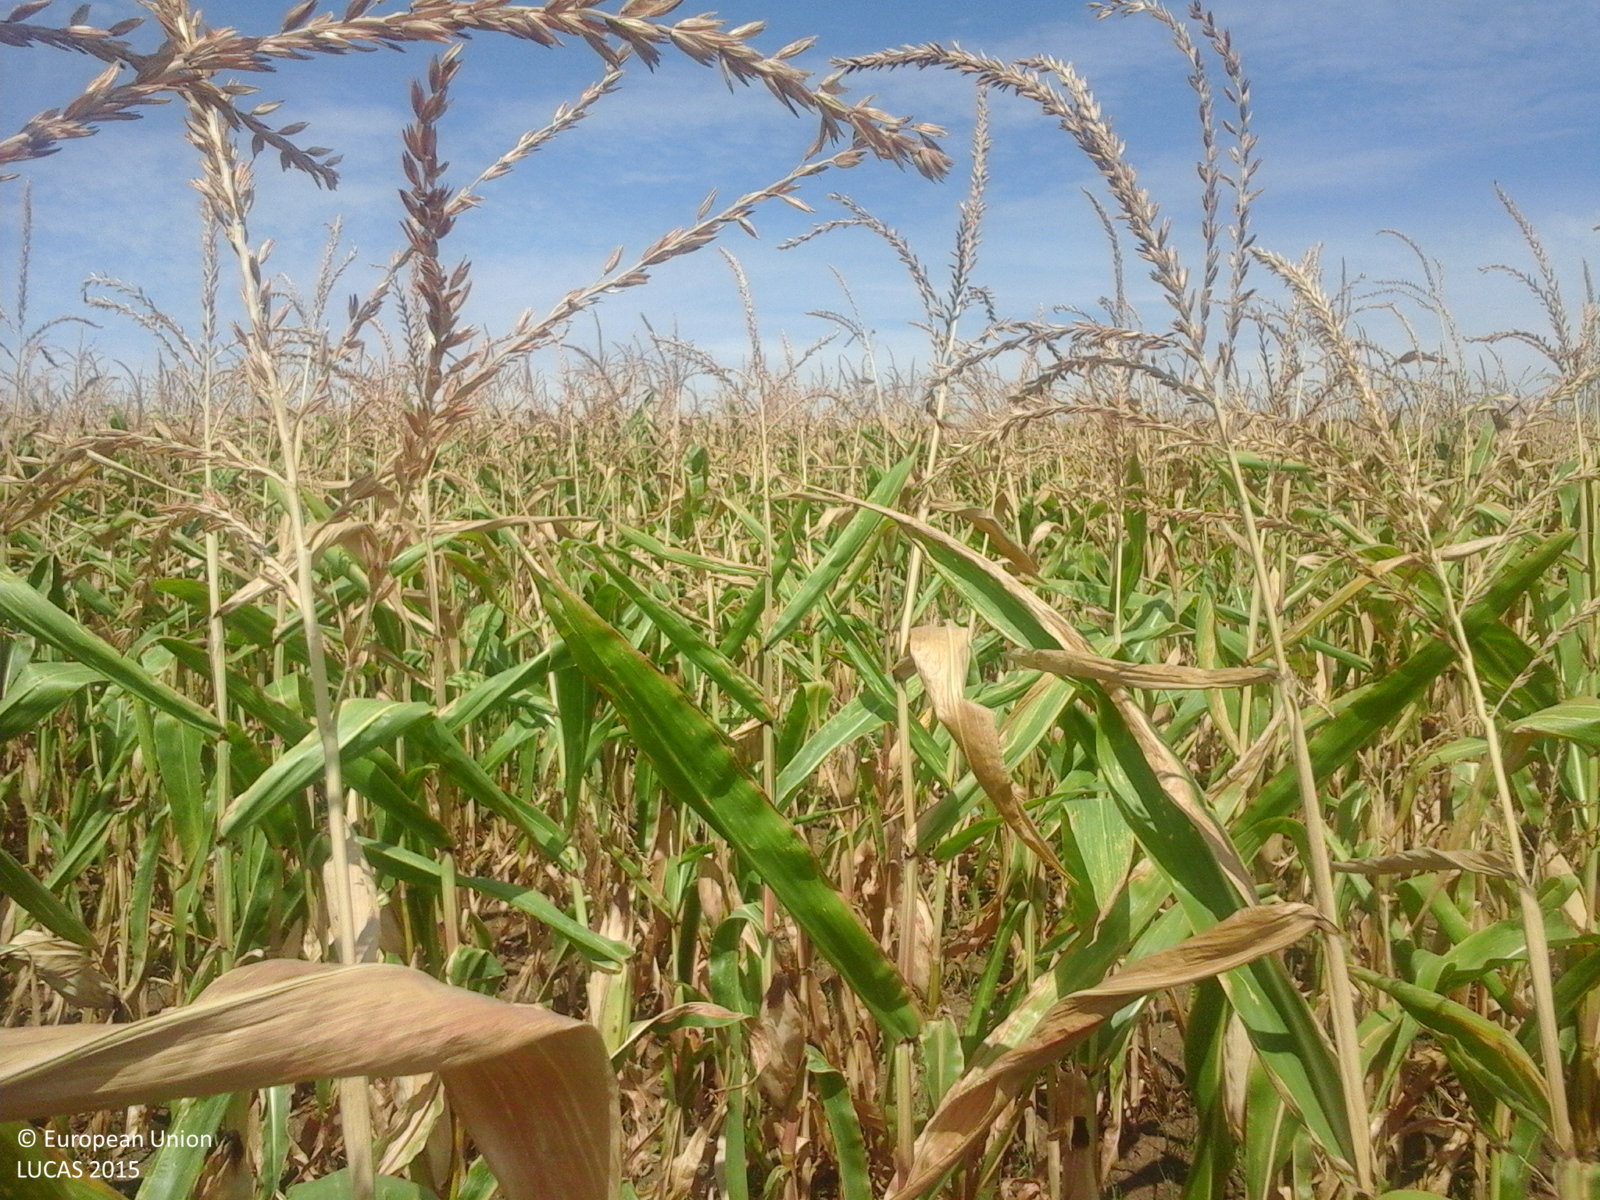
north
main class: Cropland
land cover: Maize
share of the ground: > 75 %
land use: Agriculture (excluding fallow land and kitchen gardens)
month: August
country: RO
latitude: 44.9477
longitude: 21.6530
